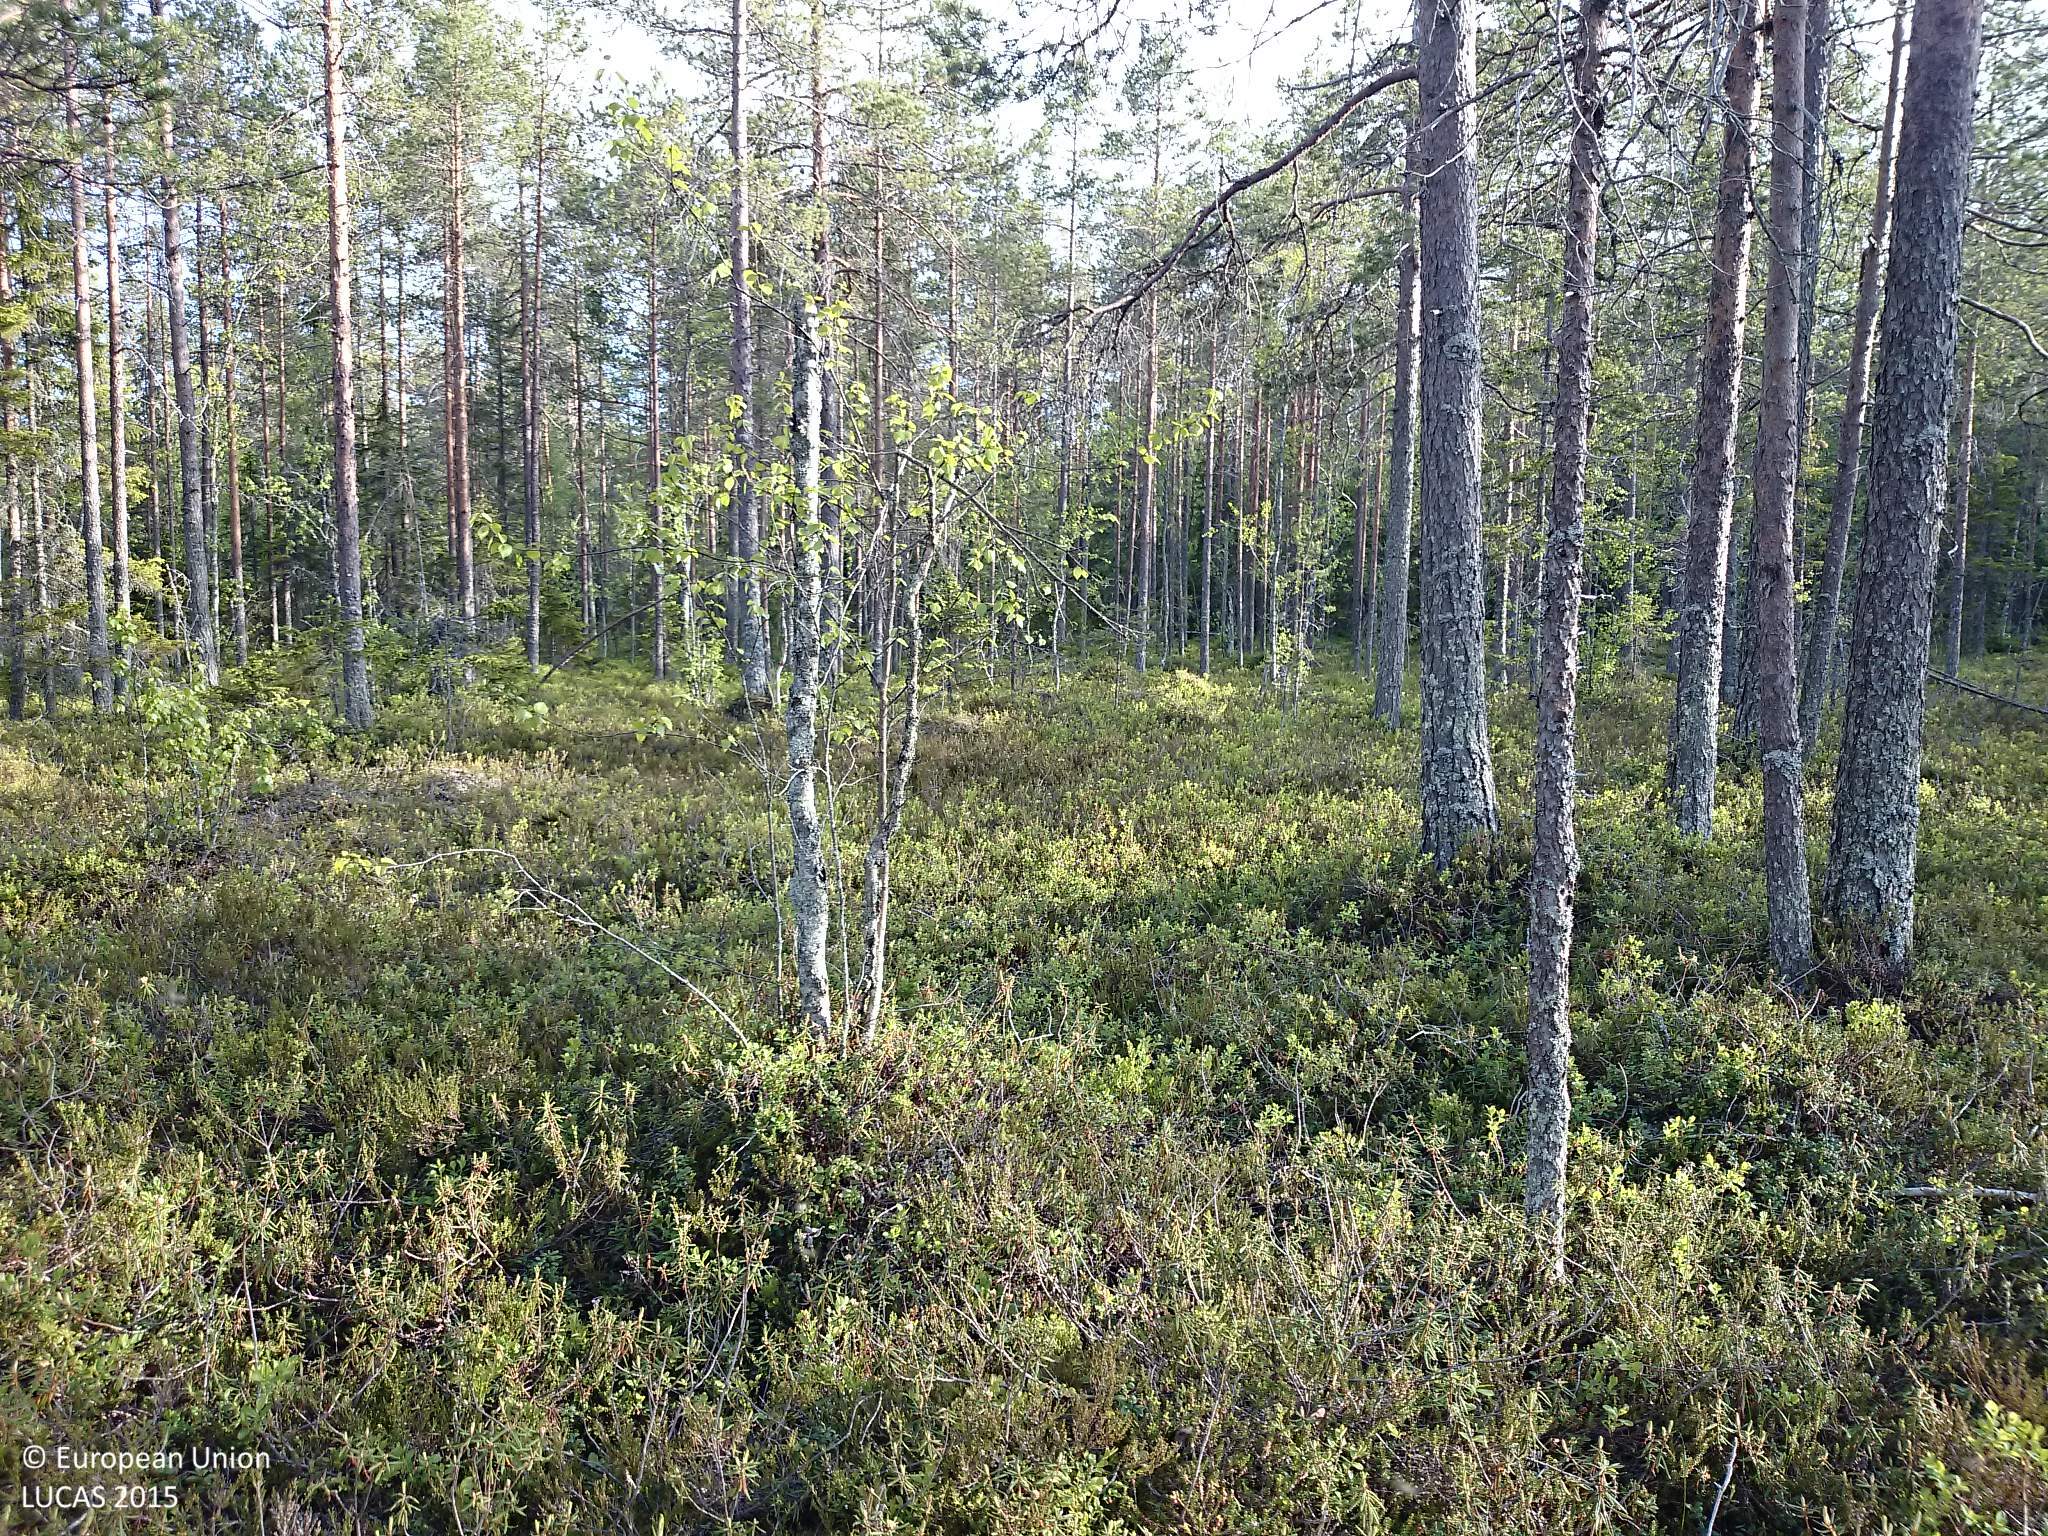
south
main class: Woodland
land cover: Pine dominated coniferous woodland
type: boreal forest
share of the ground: 50 - 75 %
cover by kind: coniferous forest trees 60 %, shrubs 40 %
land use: Forestry
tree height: > 5 m
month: June
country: SE
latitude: 64.0596
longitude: 20.6163
